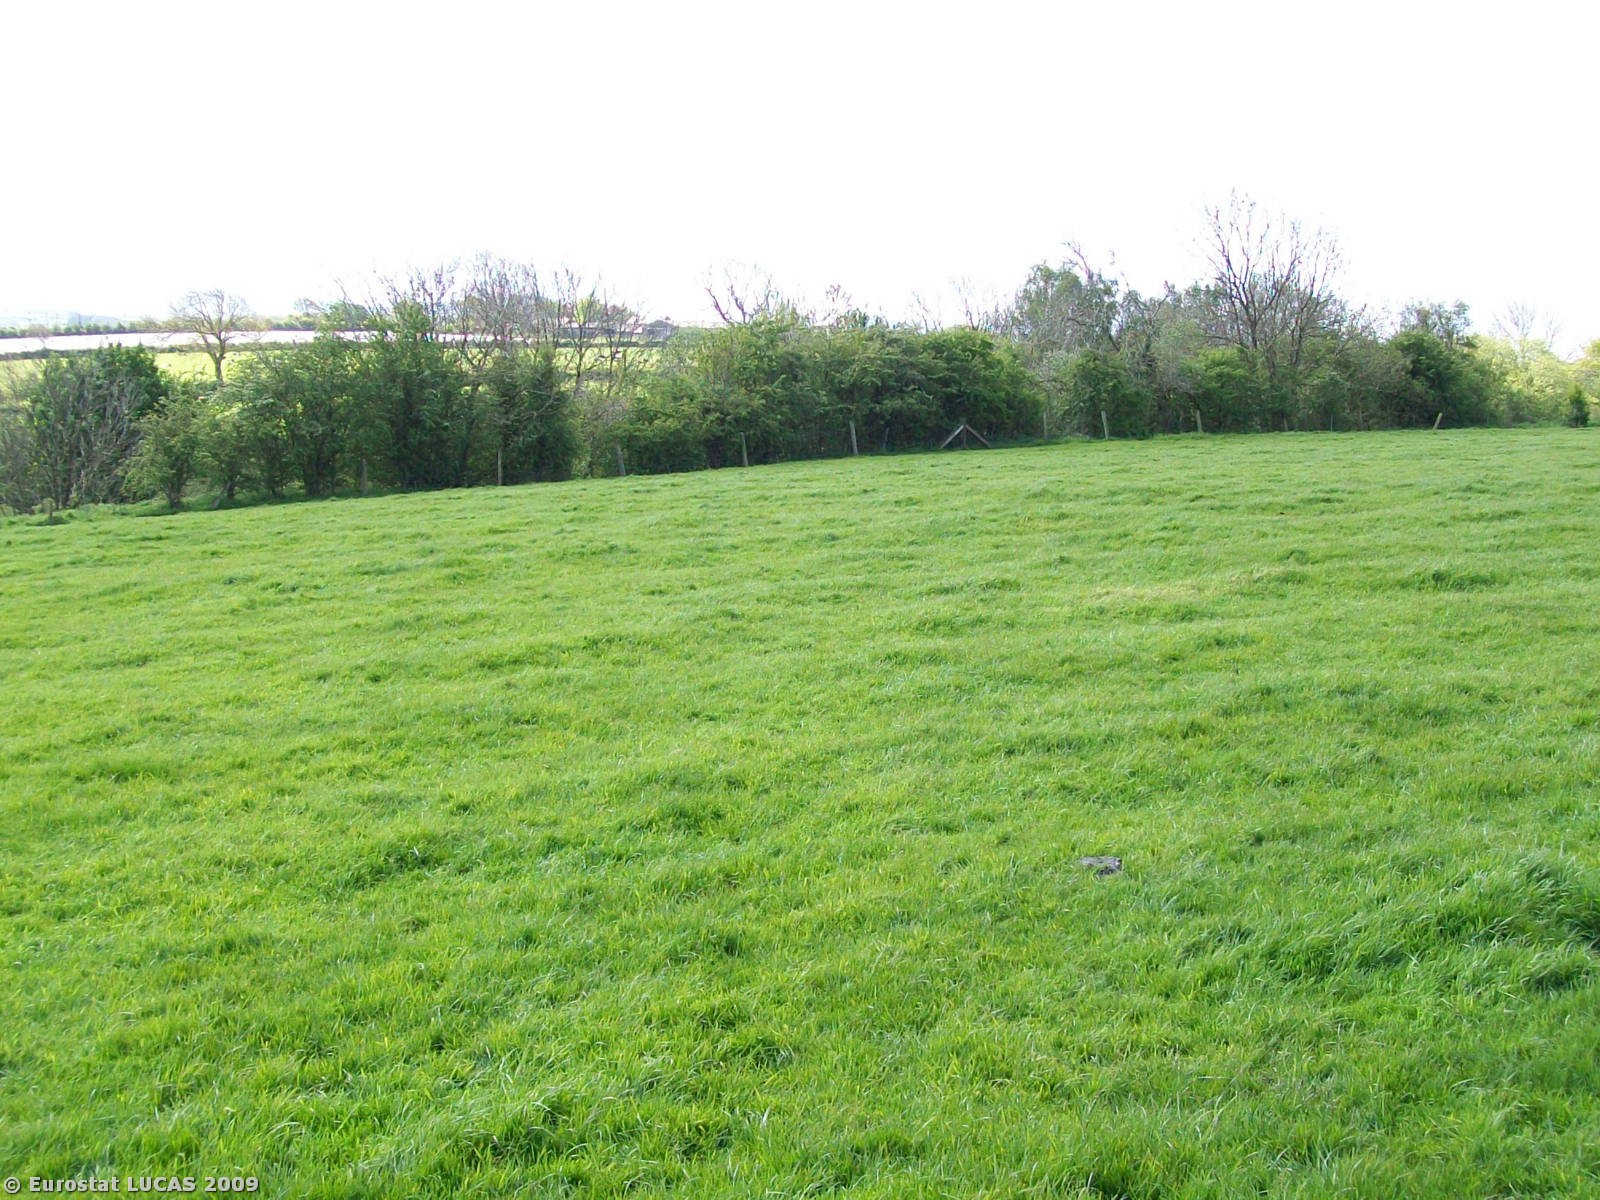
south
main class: Grassland
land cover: Grassland without tree/shrub cover
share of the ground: > 75 %
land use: Agriculture (excluding fallow land and kitchen gardens)
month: May
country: GB
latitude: 54.8063
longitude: -3.2224
